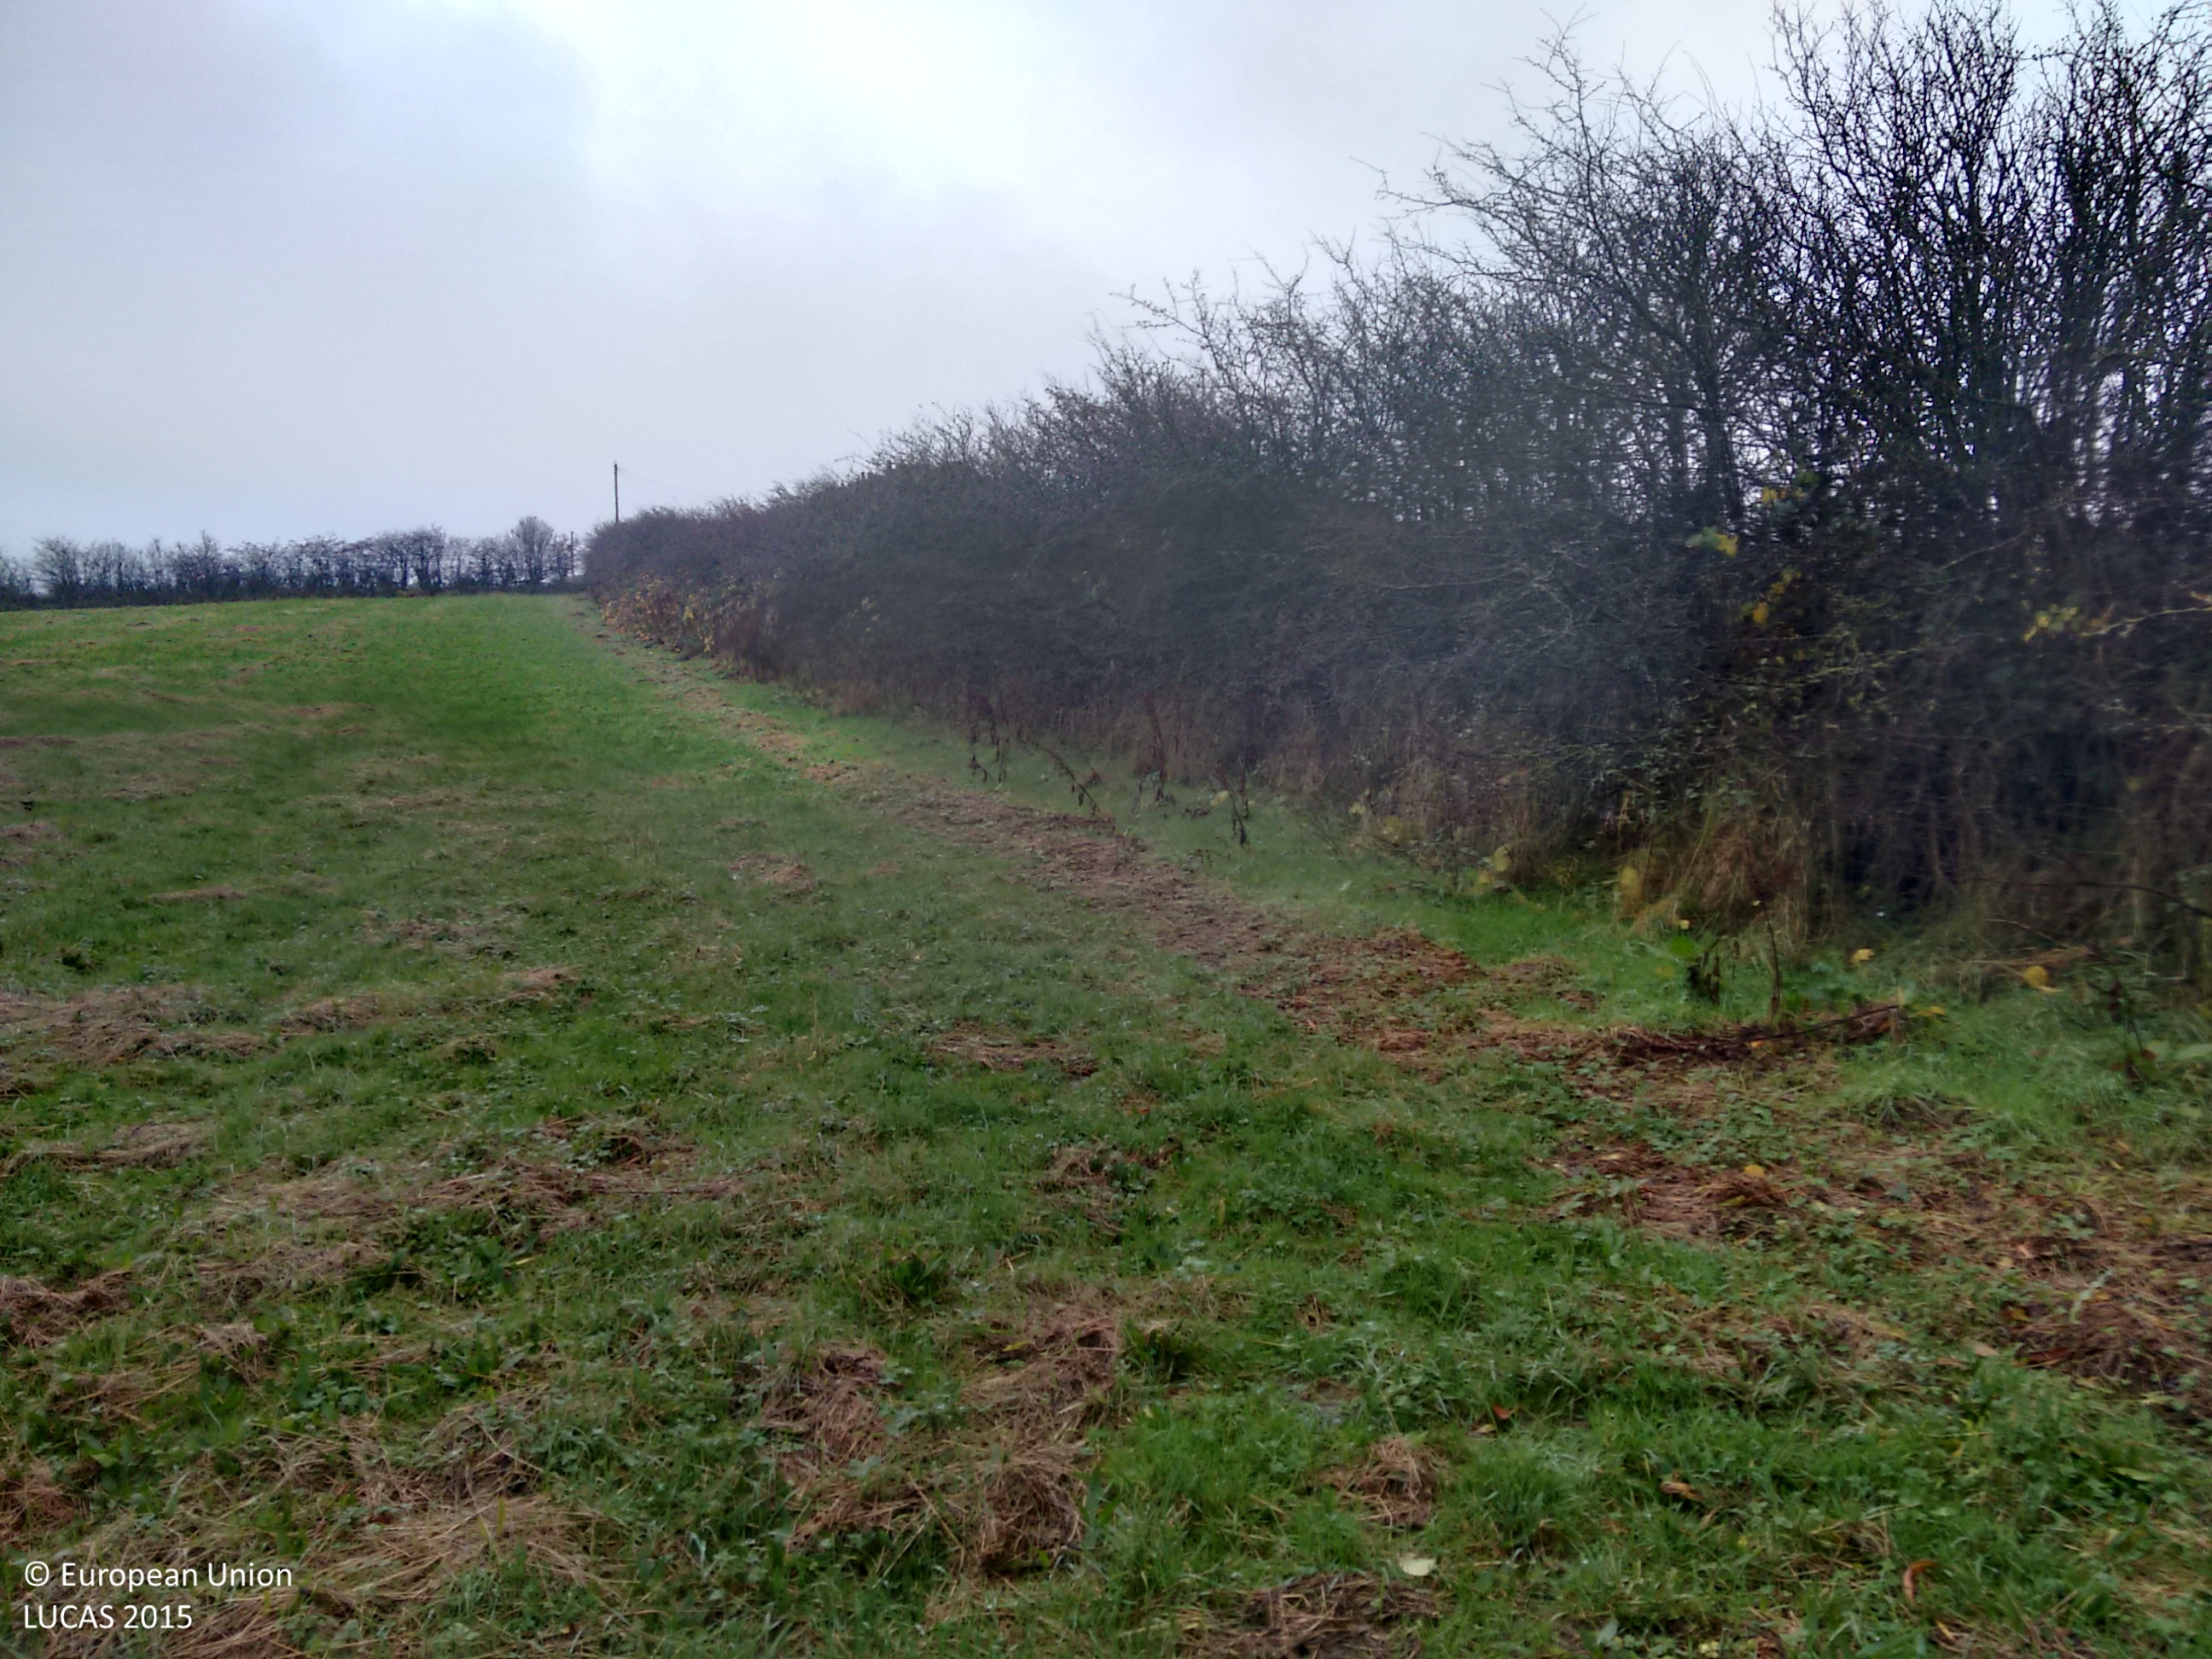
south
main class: Grassland
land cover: Grassland without tree/shrub cover
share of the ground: > 75 %
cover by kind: herbaceous plants 100 %
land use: Agriculture (excluding fallow land and kitchen gardens)
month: November
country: GB
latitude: 54.5342
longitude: -3.5434
